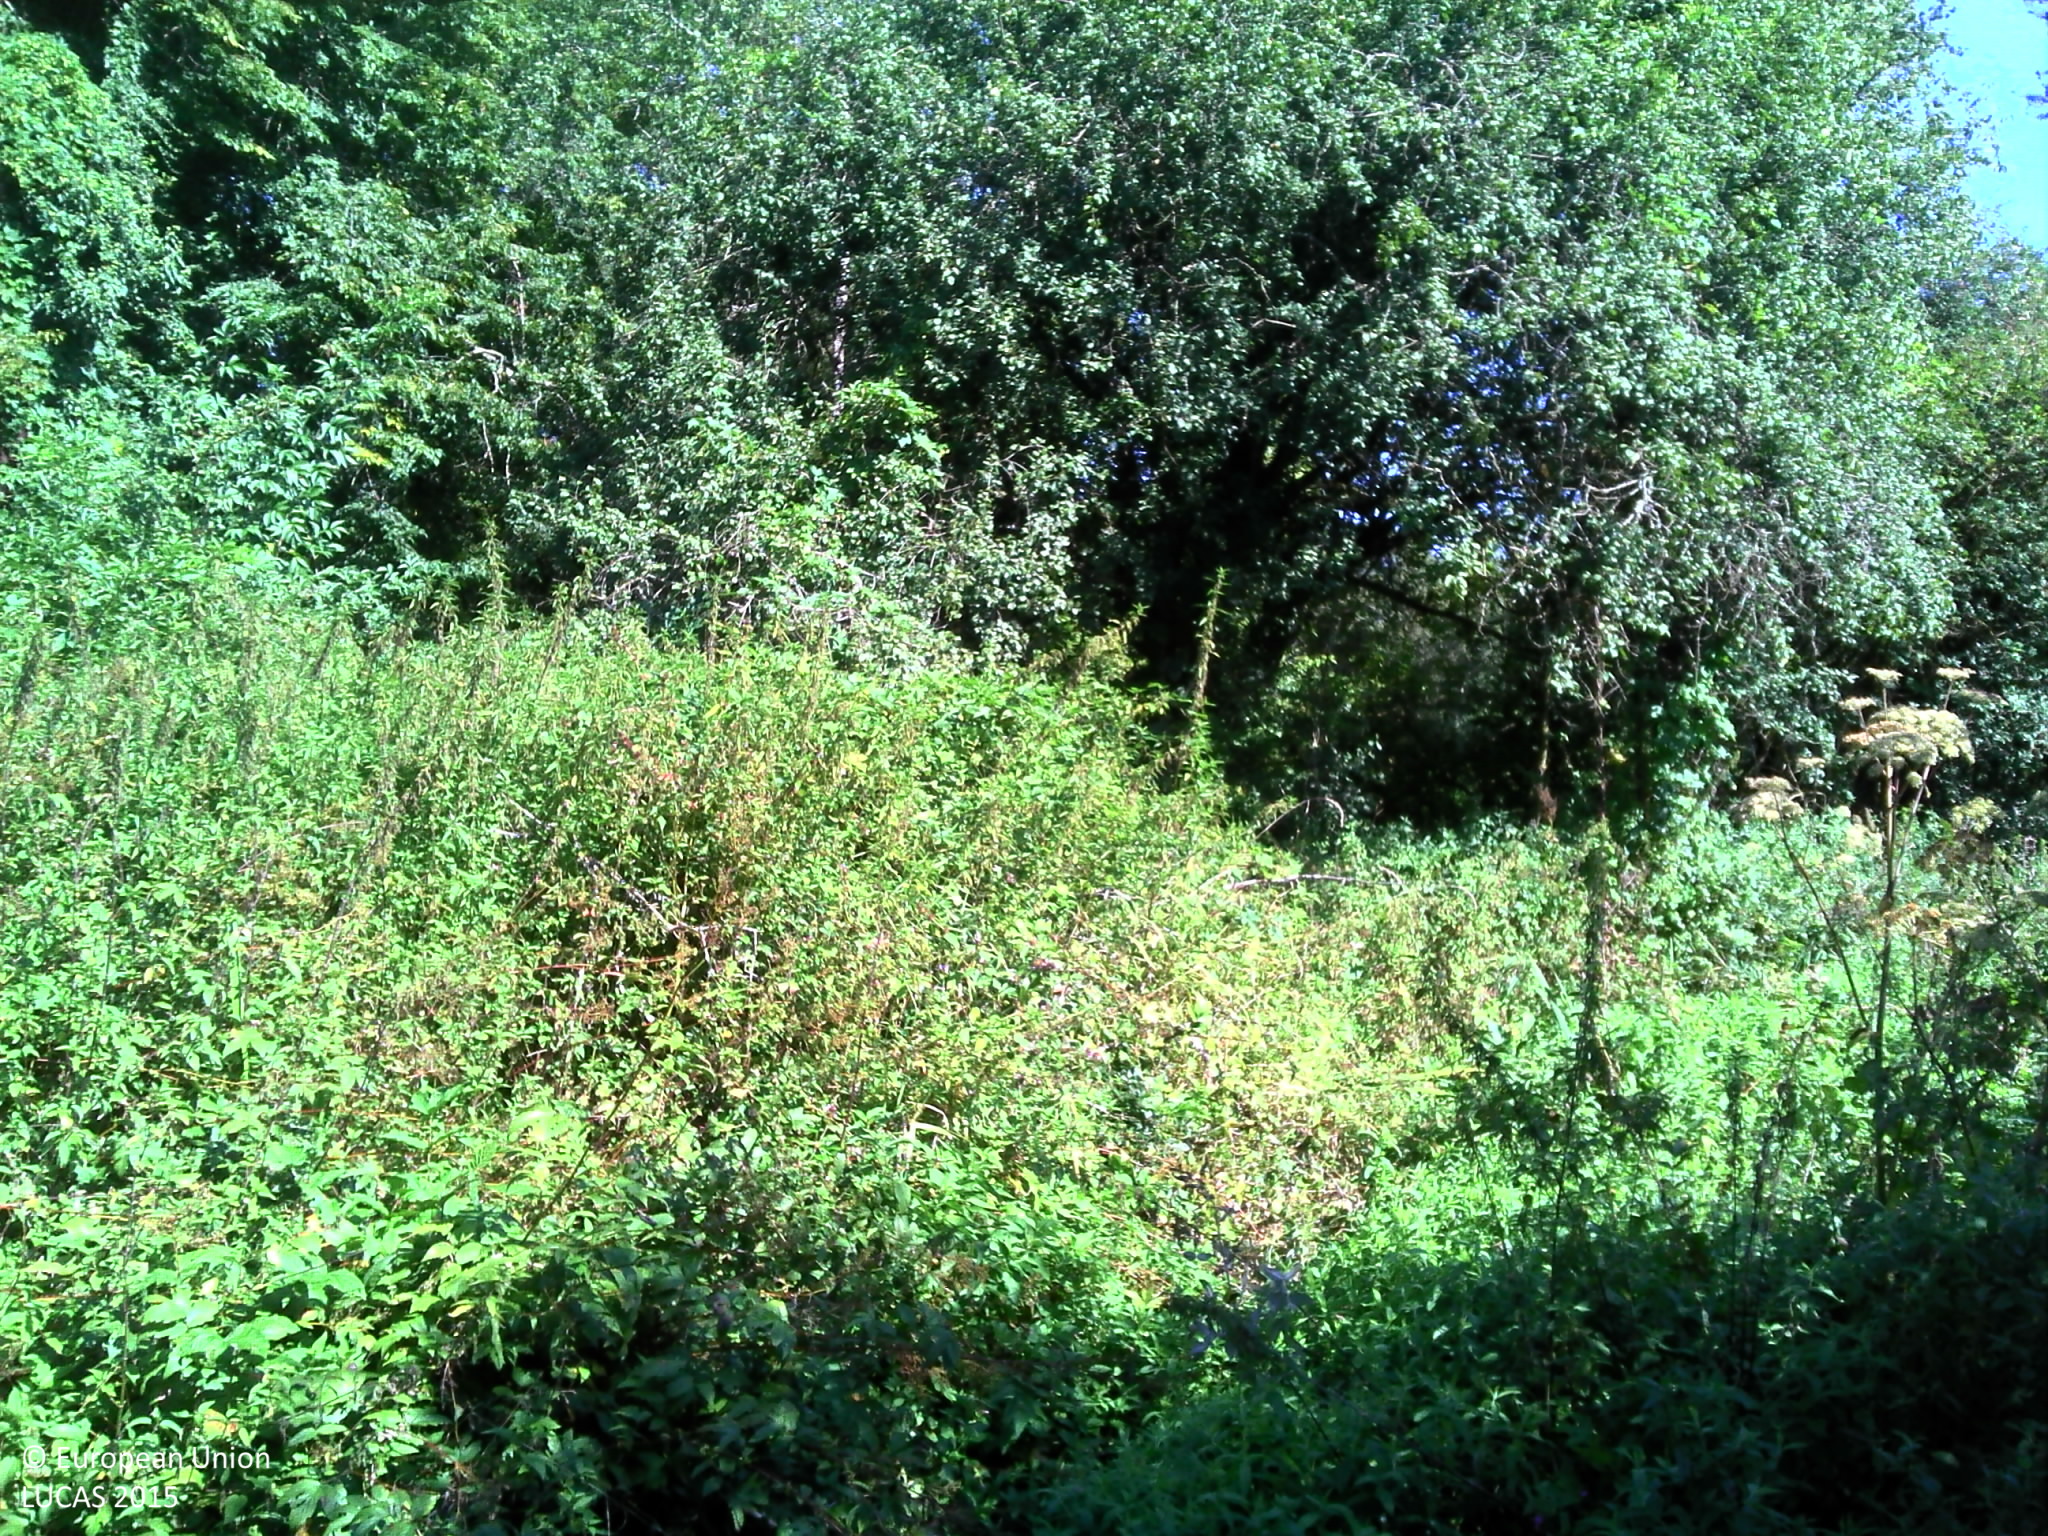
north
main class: Woodland
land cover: Broadleaved woodland
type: floodplain forest
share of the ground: > 75 %
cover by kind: broadleaved forest trees 60 %, shrubs 30 %, herbaceous plants 10 %
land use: Semi-natural and natural areas not in use
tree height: > 5 m
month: September
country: FR
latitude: 47.2764
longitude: 6.2343
